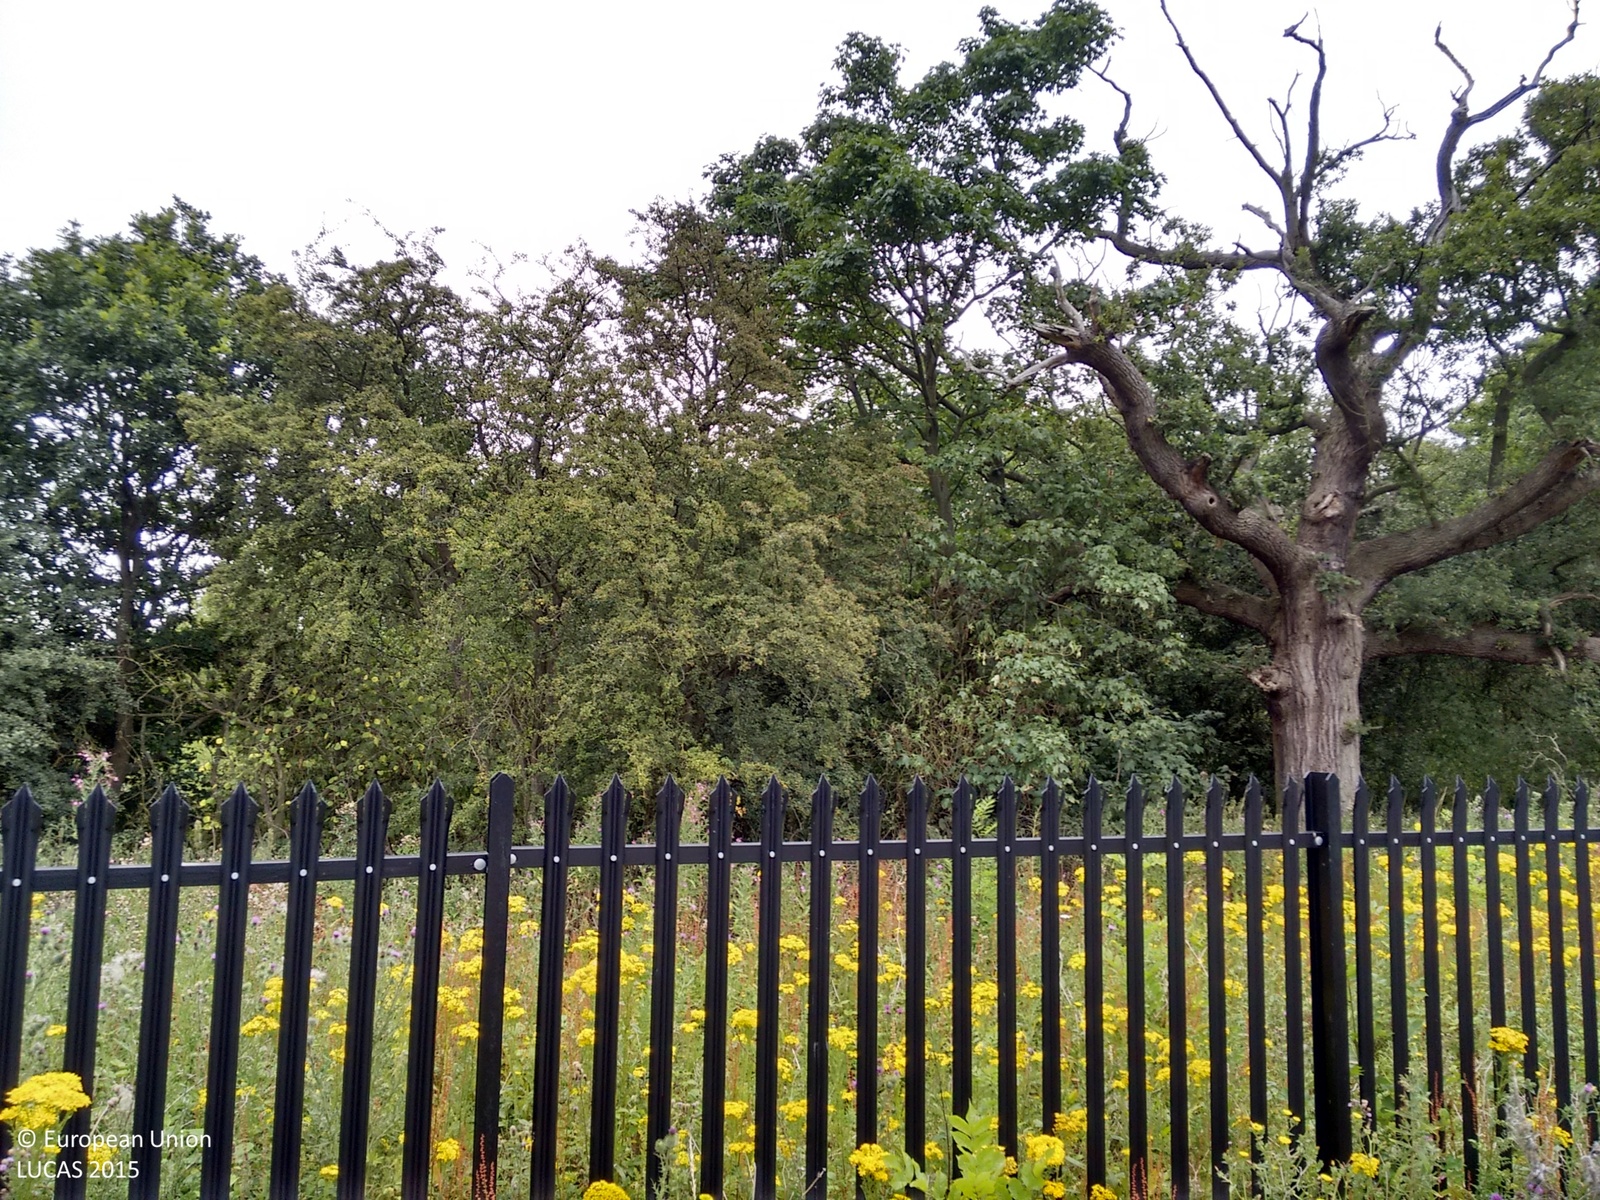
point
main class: Woodland
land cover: Broadleaved woodland
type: mesophytic deciduous forest
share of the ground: 25 - 50 %
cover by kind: broadleaved forest trees 50 %, shrubs 40 %, herbaceous plants 10 %
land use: Abandoned areas
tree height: > 5 m
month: July
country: GB
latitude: 51.6424
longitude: -0.2522
